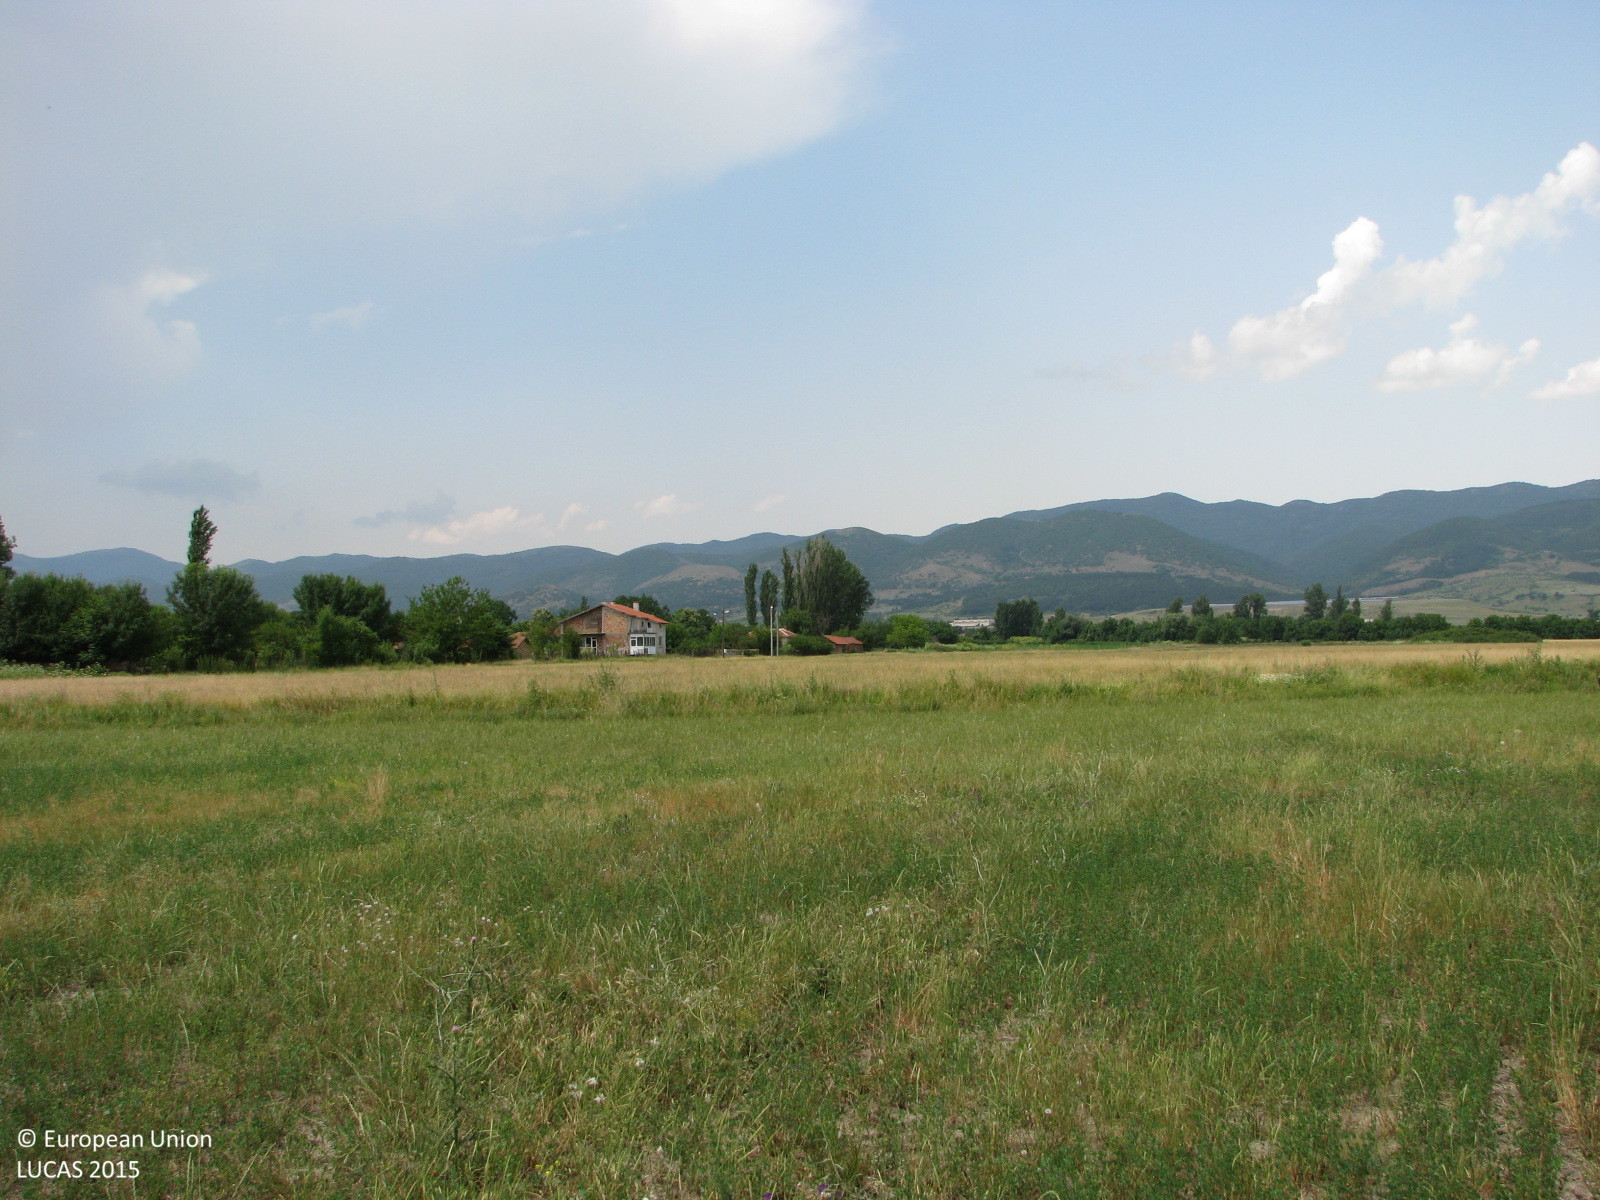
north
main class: Cropland
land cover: Lucerne
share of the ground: > 75 %
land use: Agriculture (excluding fallow land and kitchen gardens)
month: June
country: BG
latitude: 42.6254
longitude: 26.5432
